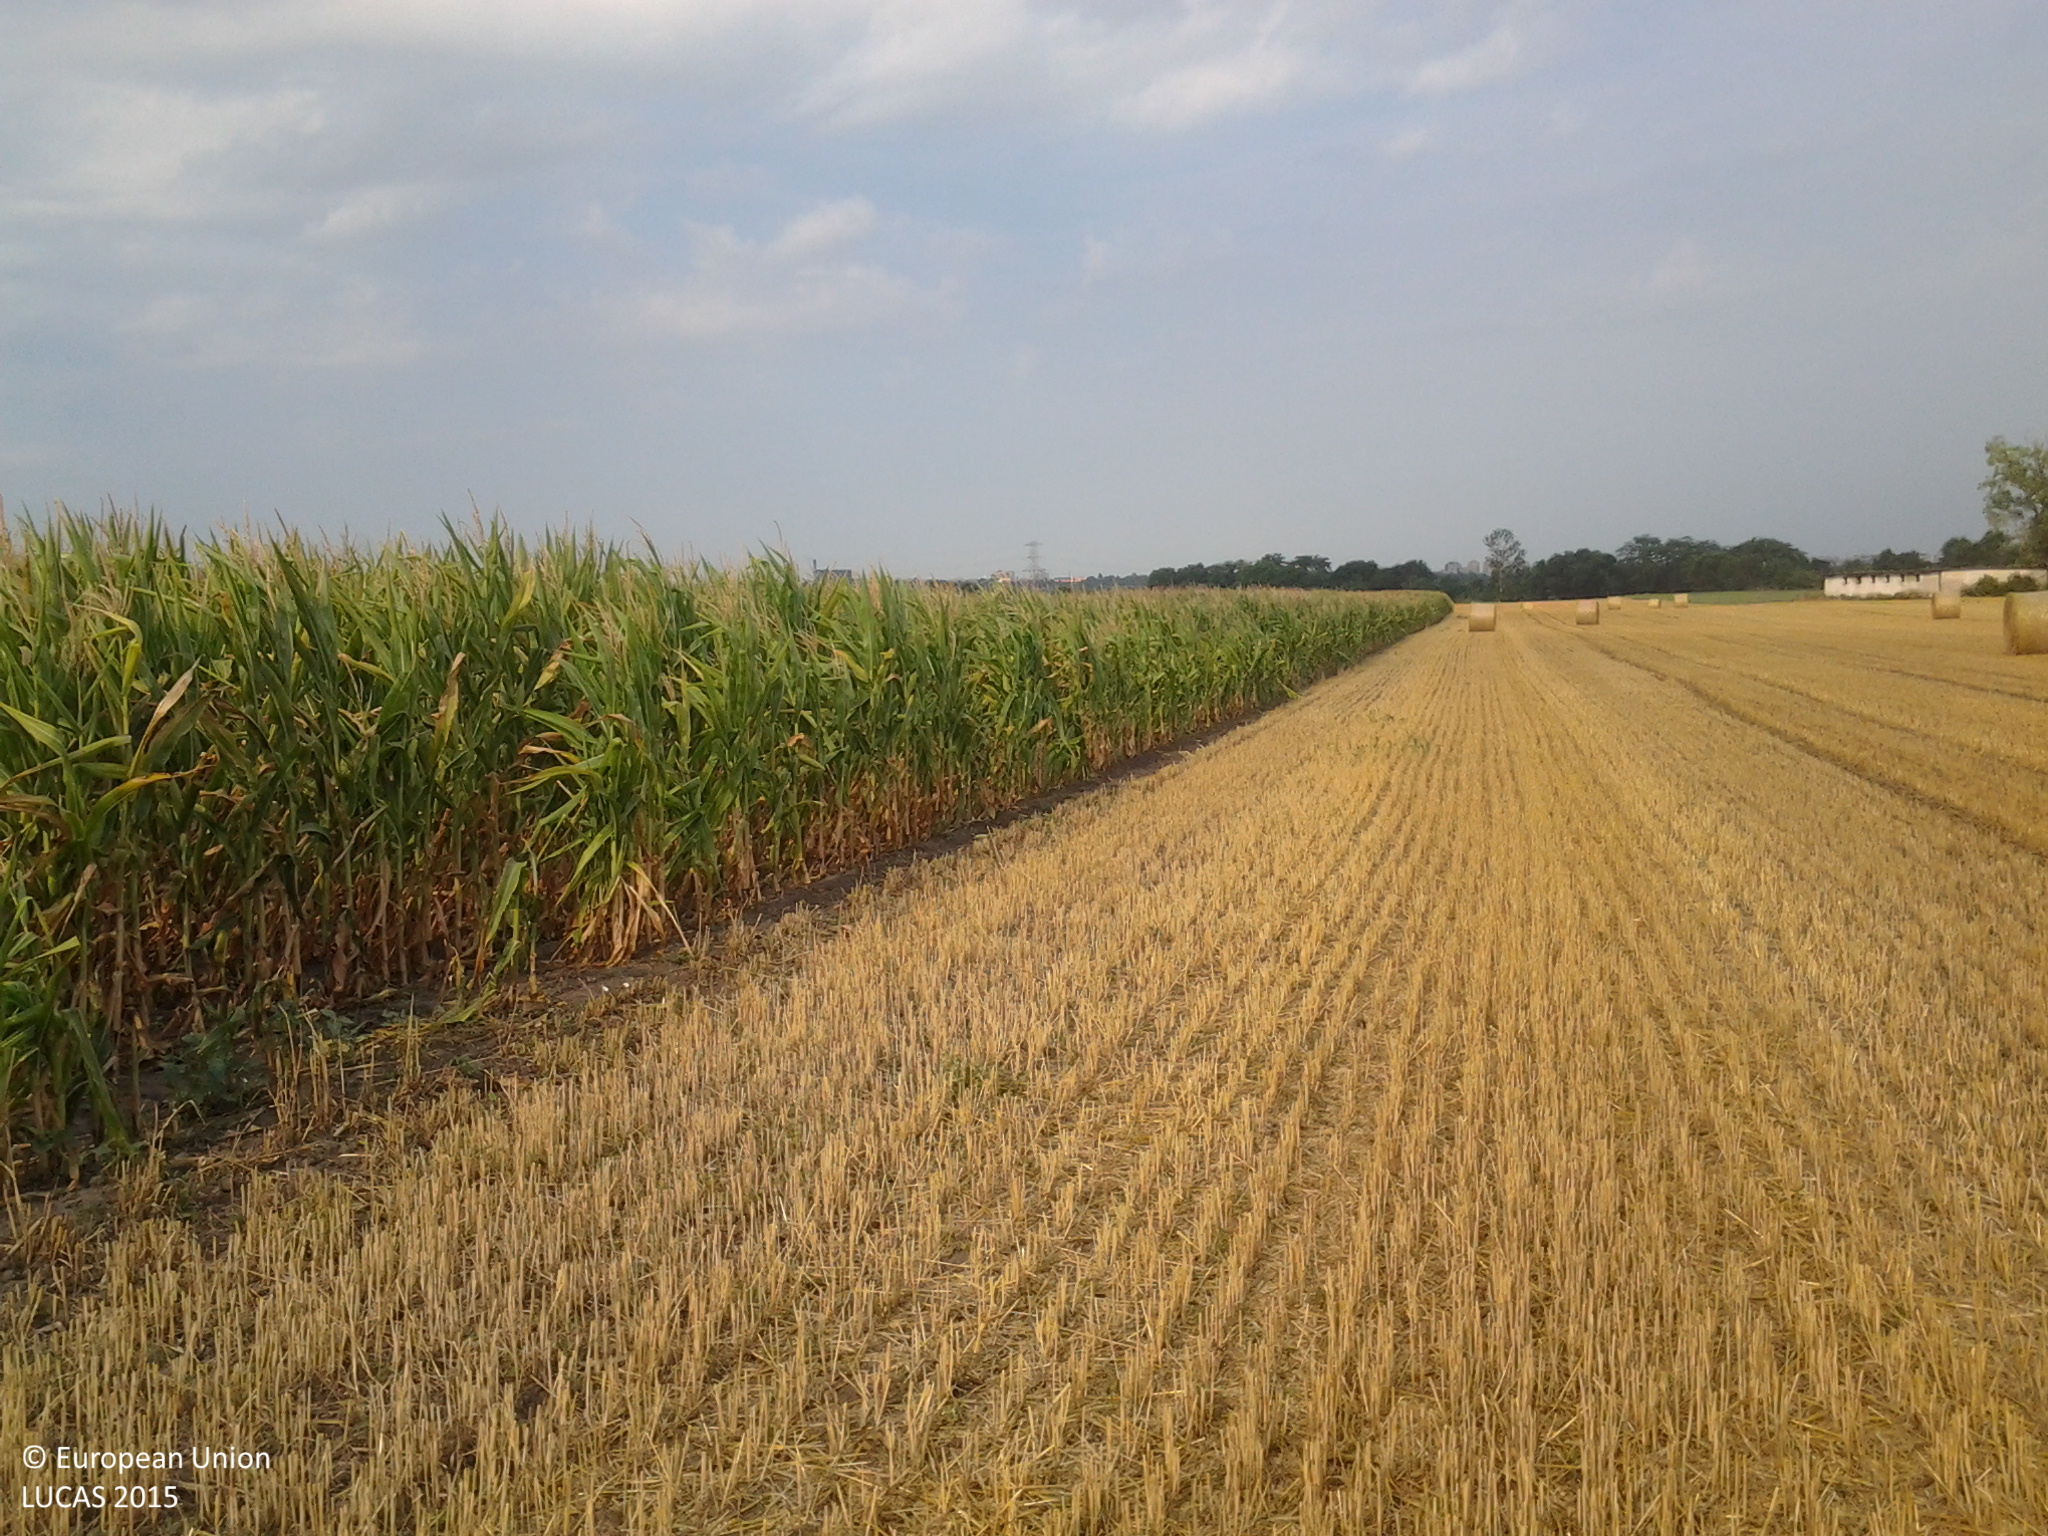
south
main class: Cropland
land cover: Common wheat
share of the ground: 25 - 50 %
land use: Agriculture (excluding fallow land and kitchen gardens)
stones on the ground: < 10 %
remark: Harvested field
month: July
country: HU
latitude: 46.9681
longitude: 18.9923
